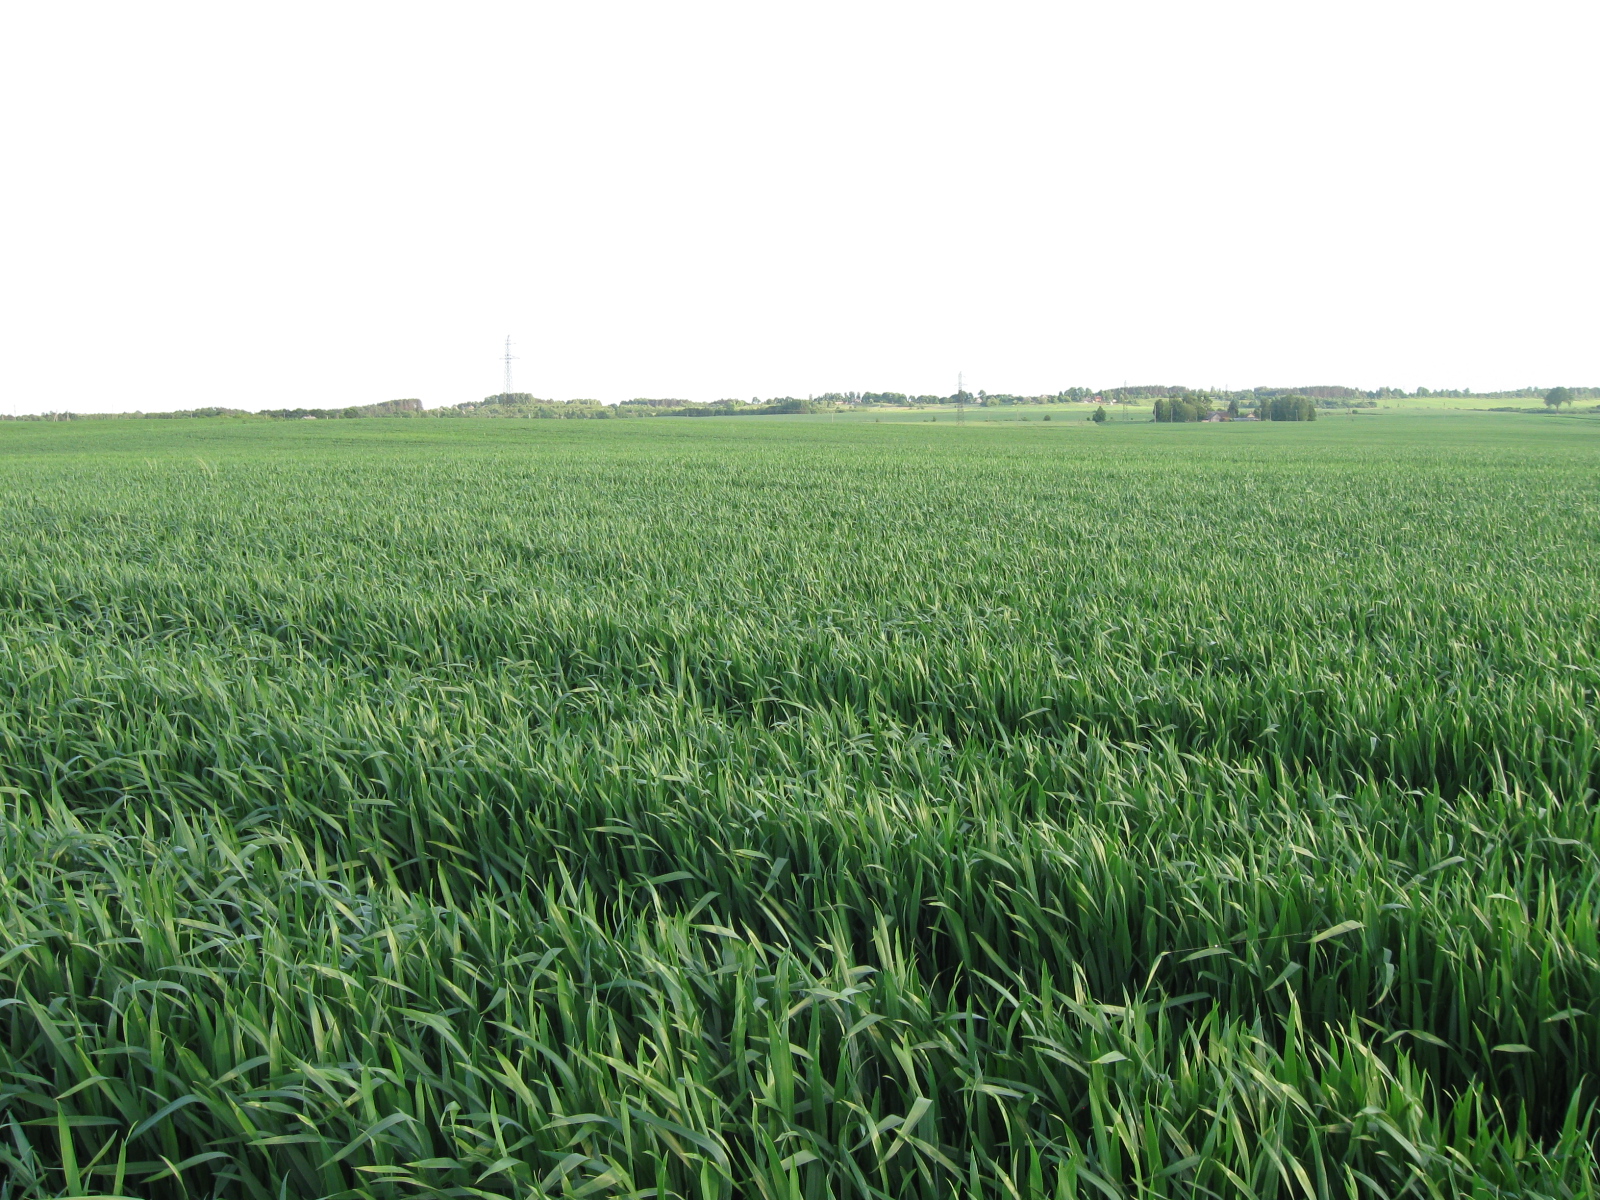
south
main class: Cropland
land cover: Common wheat
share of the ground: > 75 %
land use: Agriculture (excluding fallow land and kitchen gardens)
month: June
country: LT
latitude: 55.0384
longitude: 24.0977
